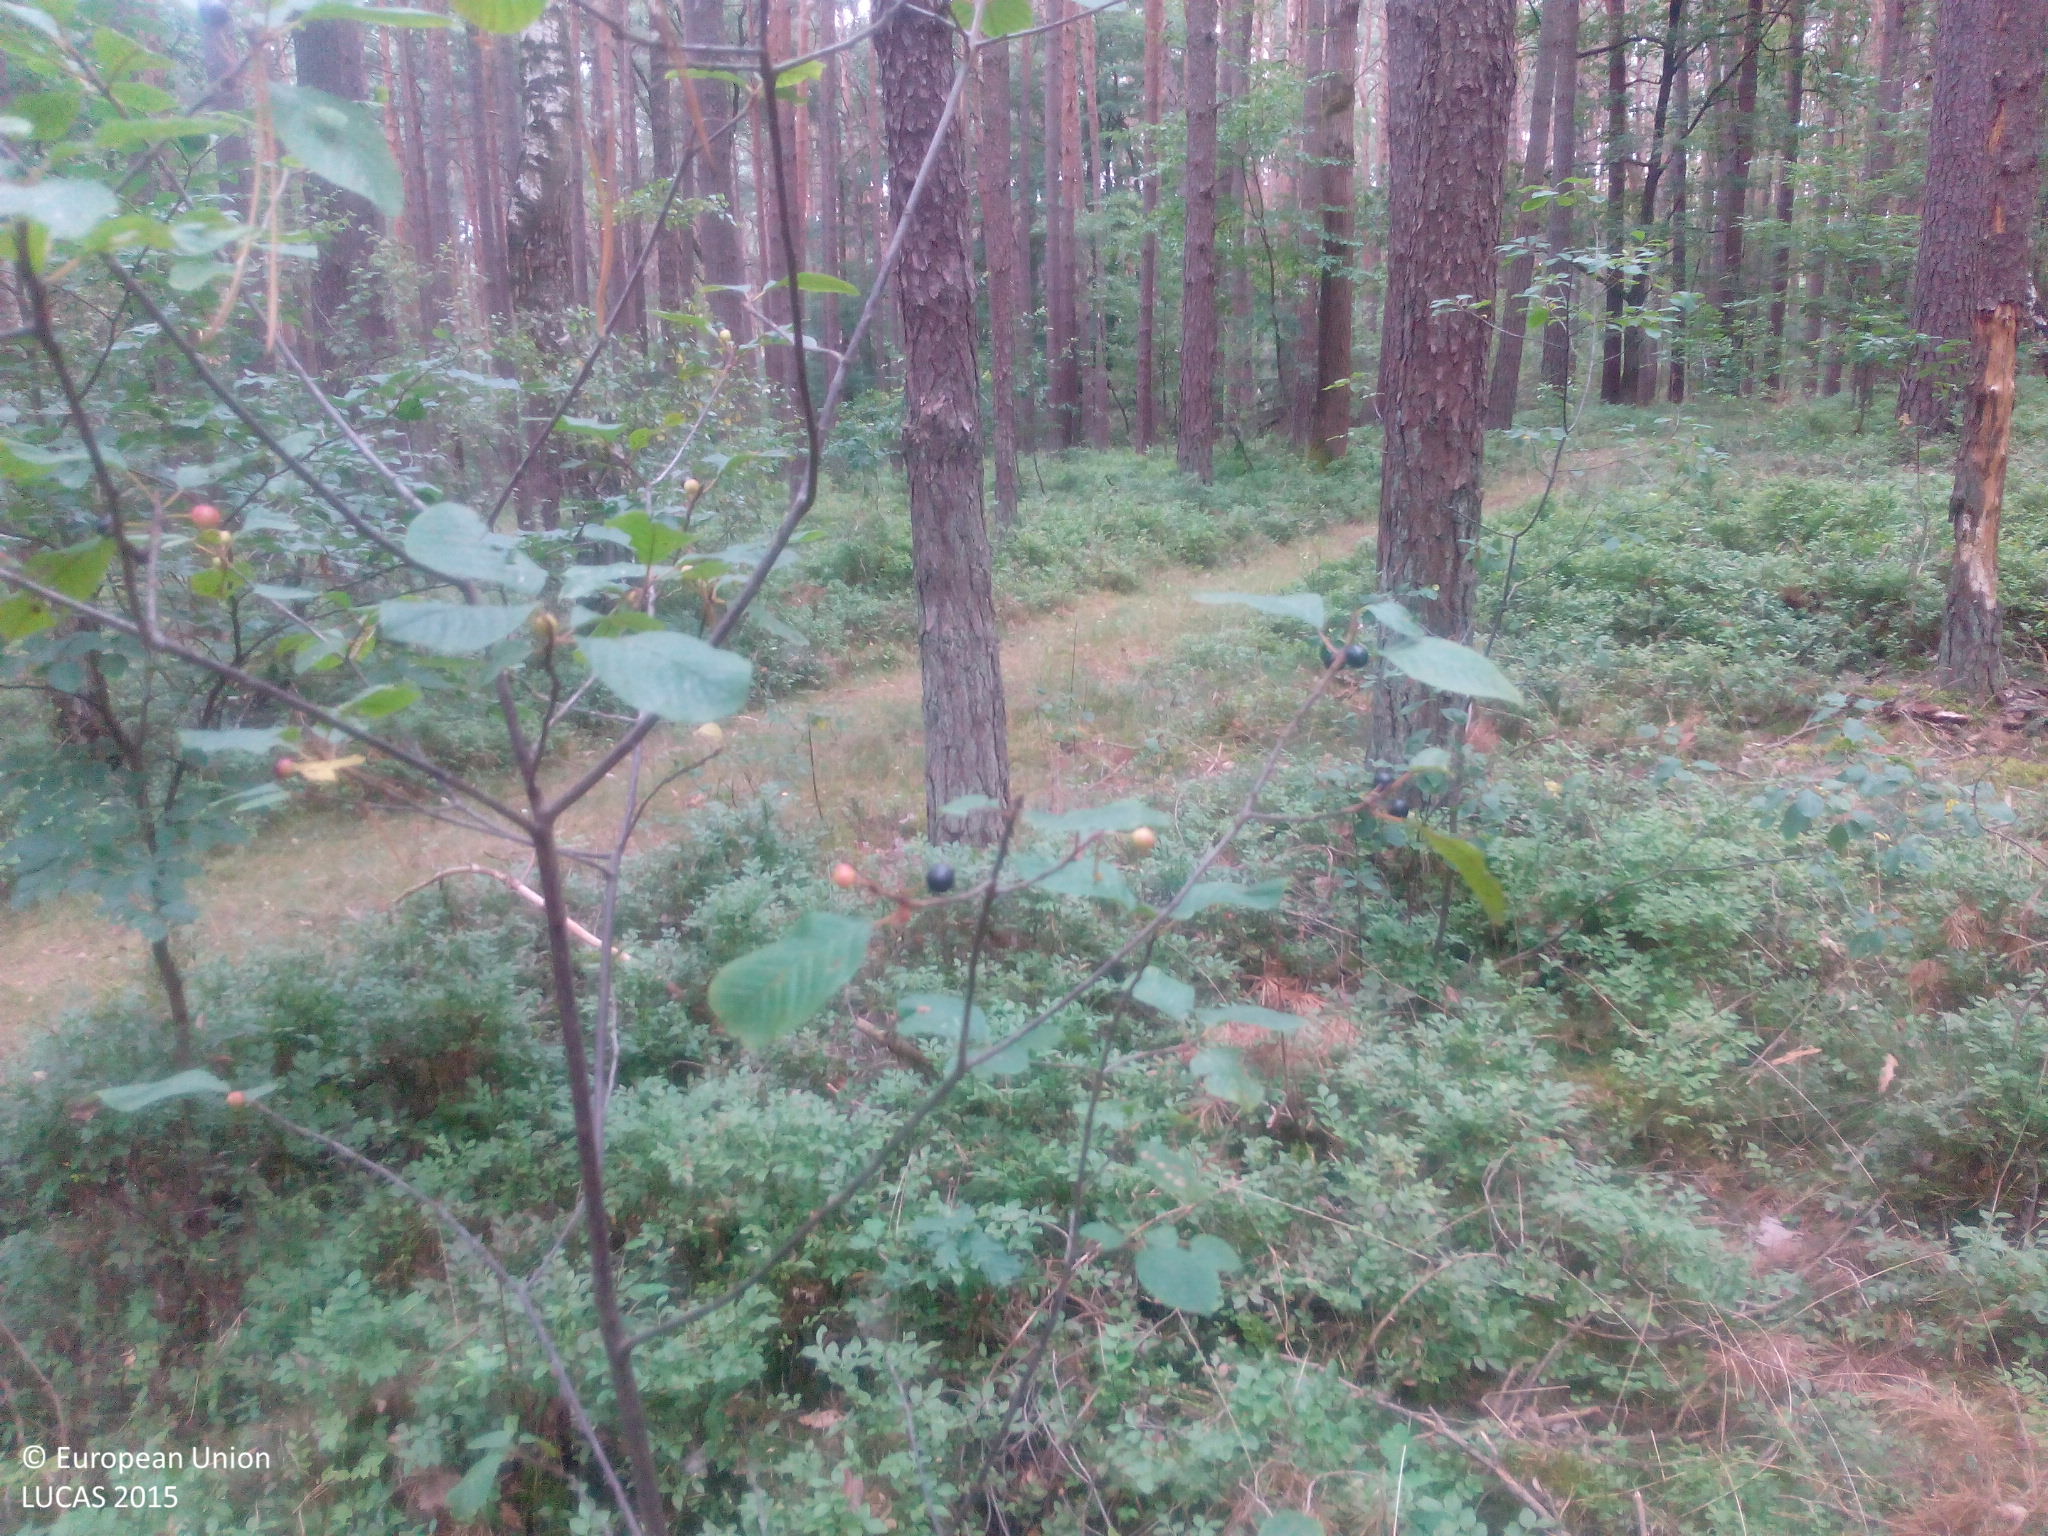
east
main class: Woodland
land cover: Pine dominated coniferous woodland
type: hemiboreal forest and nemoral coniferous forest and mixed broadleaved-coniferous forest
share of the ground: > 75 %
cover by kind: coniferous forest trees 70 %, shrubs 20 %, broadleaved forest trees 10 %
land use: Forestry
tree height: > 5 m
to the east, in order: Pine dominated coniferous woodland; Tracks; Pine dominated coniferous woodland; Grass margins; Paved roads, cycling and walking lanes; Grass margins; Ditches and canals; Grass margins; Paved roads, cycling and walking lanes; Grassland without tree/shrub cover; Other coniferous woodland
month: July
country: DE
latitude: 49.6052
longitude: 10.8991
